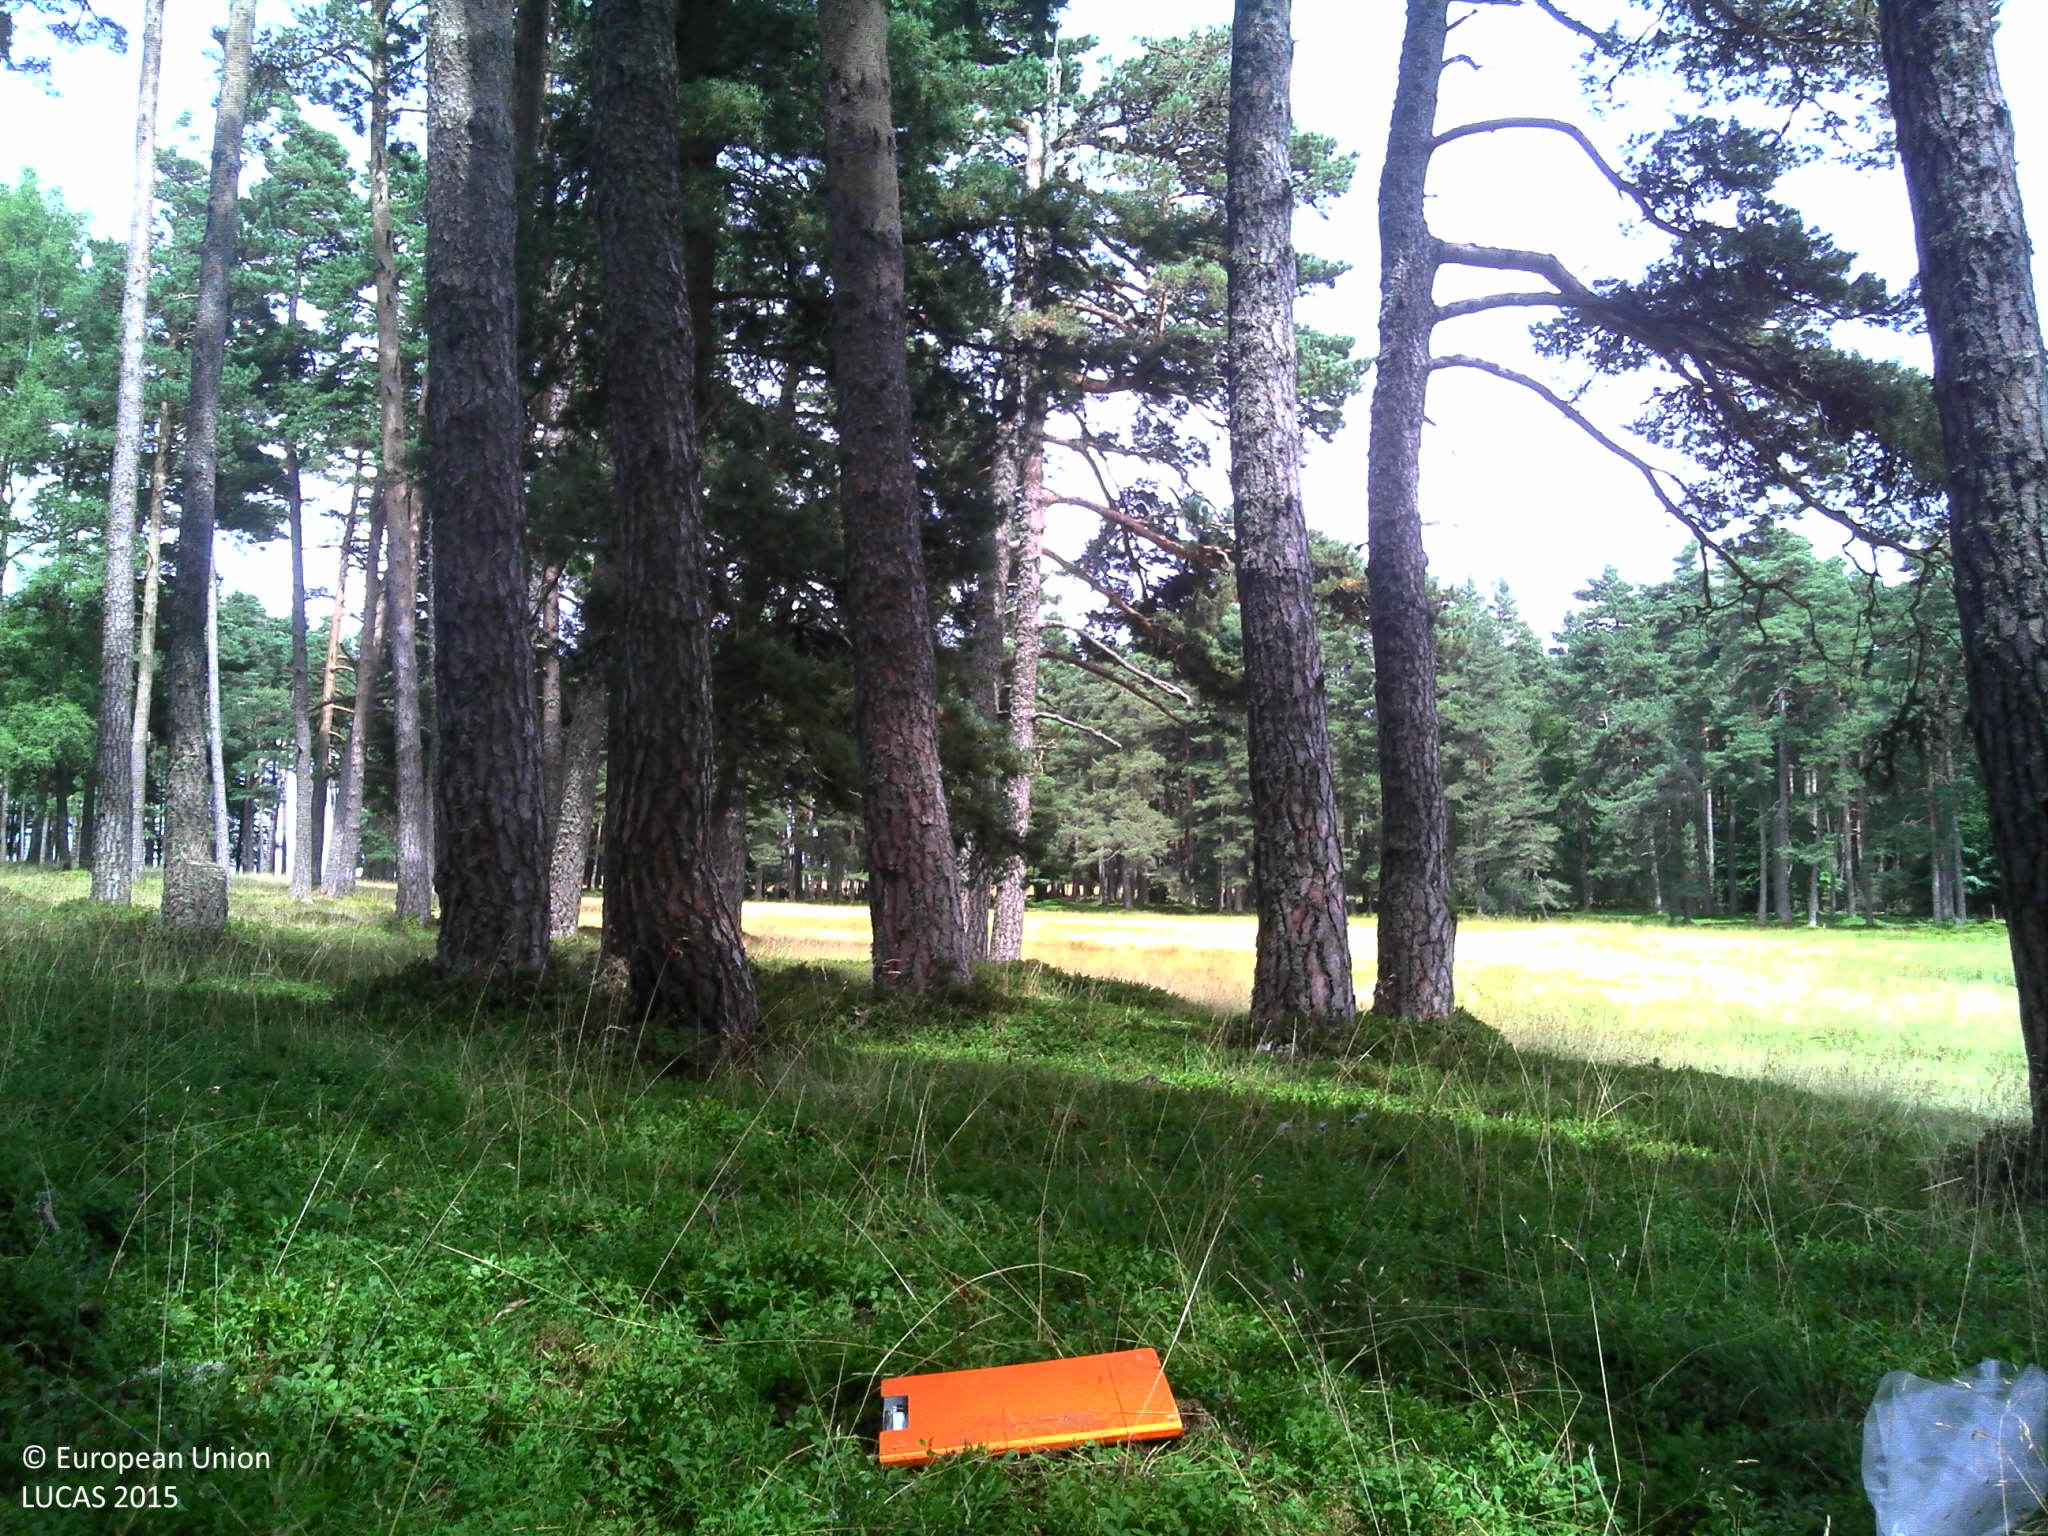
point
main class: Woodland
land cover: Pine dominated coniferous woodland
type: hemiboreal forest and nemoral coniferous forest and mixed broadleaved-coniferous forest
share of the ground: > 75 %
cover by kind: coniferous forest trees 95 %, broadleaved forest trees 5 %
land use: Forestry
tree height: > 5 m
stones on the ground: 10 - 25 %
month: July
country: FR
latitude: 44.8483
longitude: 3.1581
